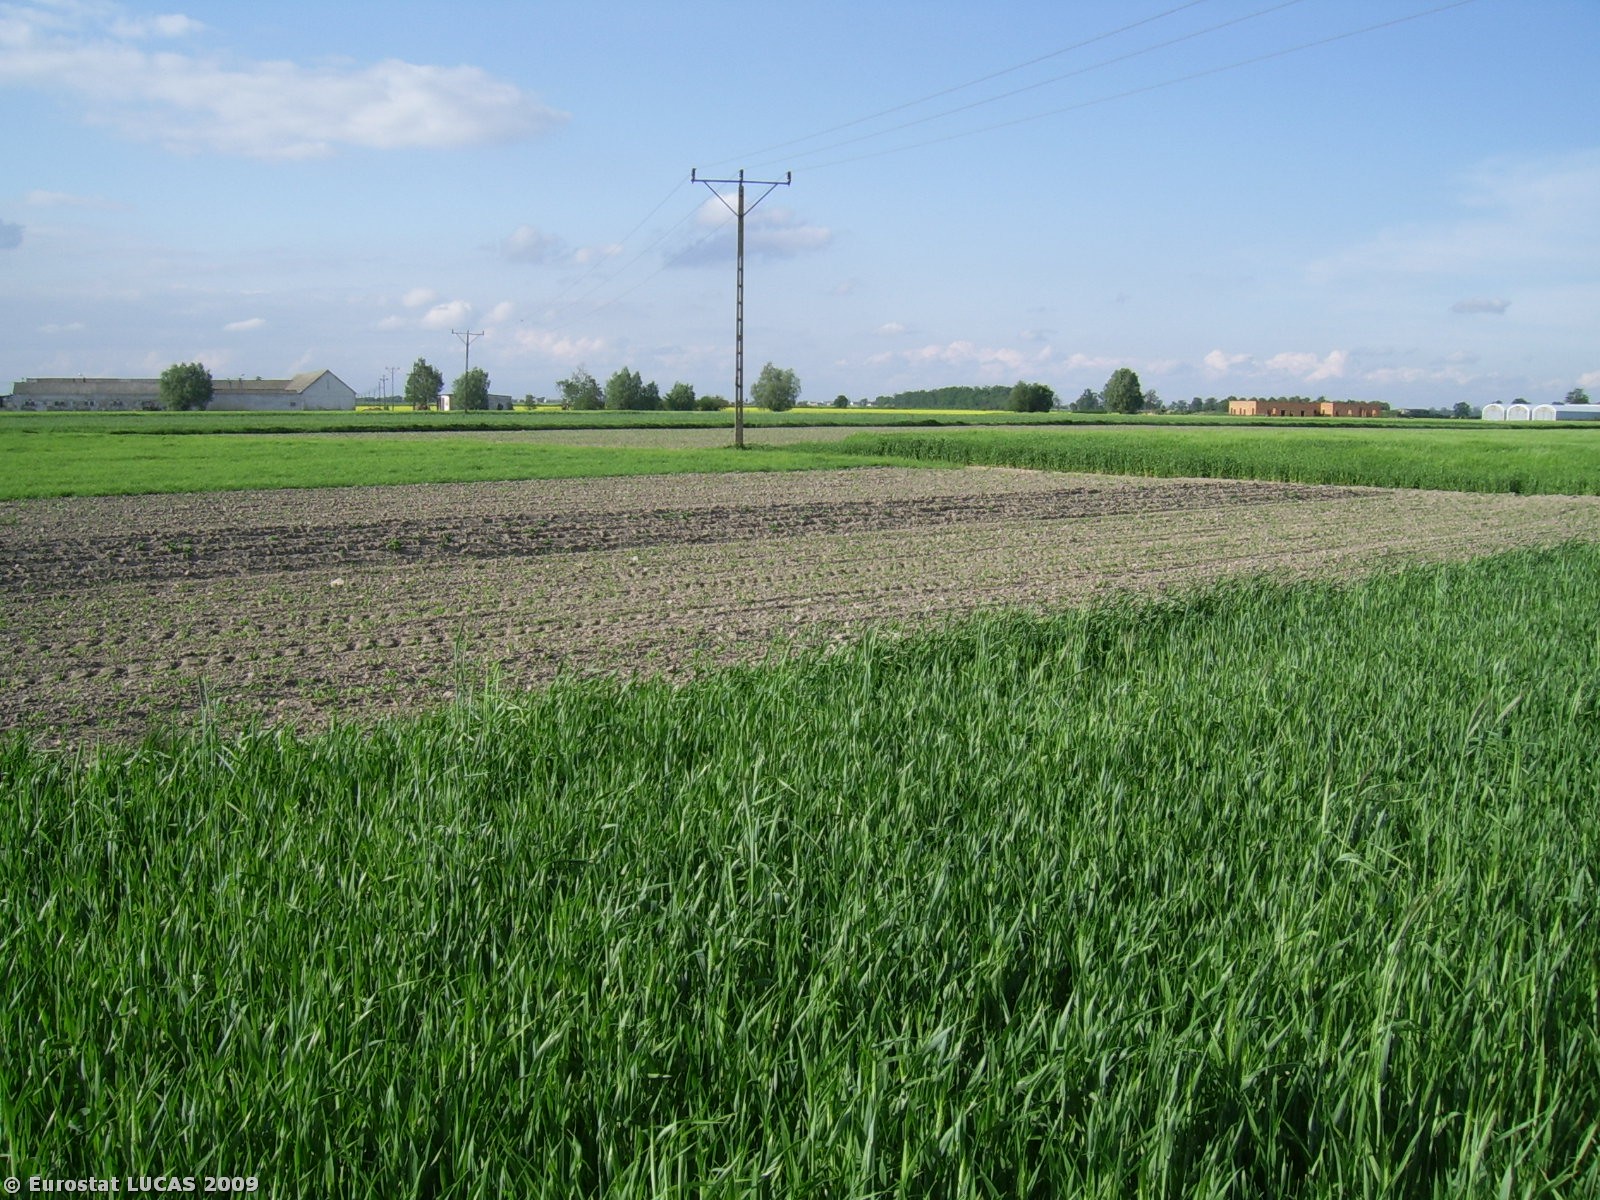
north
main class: Cropland
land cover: Triticale
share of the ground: > 75 %
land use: Agriculture (excluding fallow land and kitchen gardens)
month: May
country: PL
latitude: 51.8533
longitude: 16.8766
